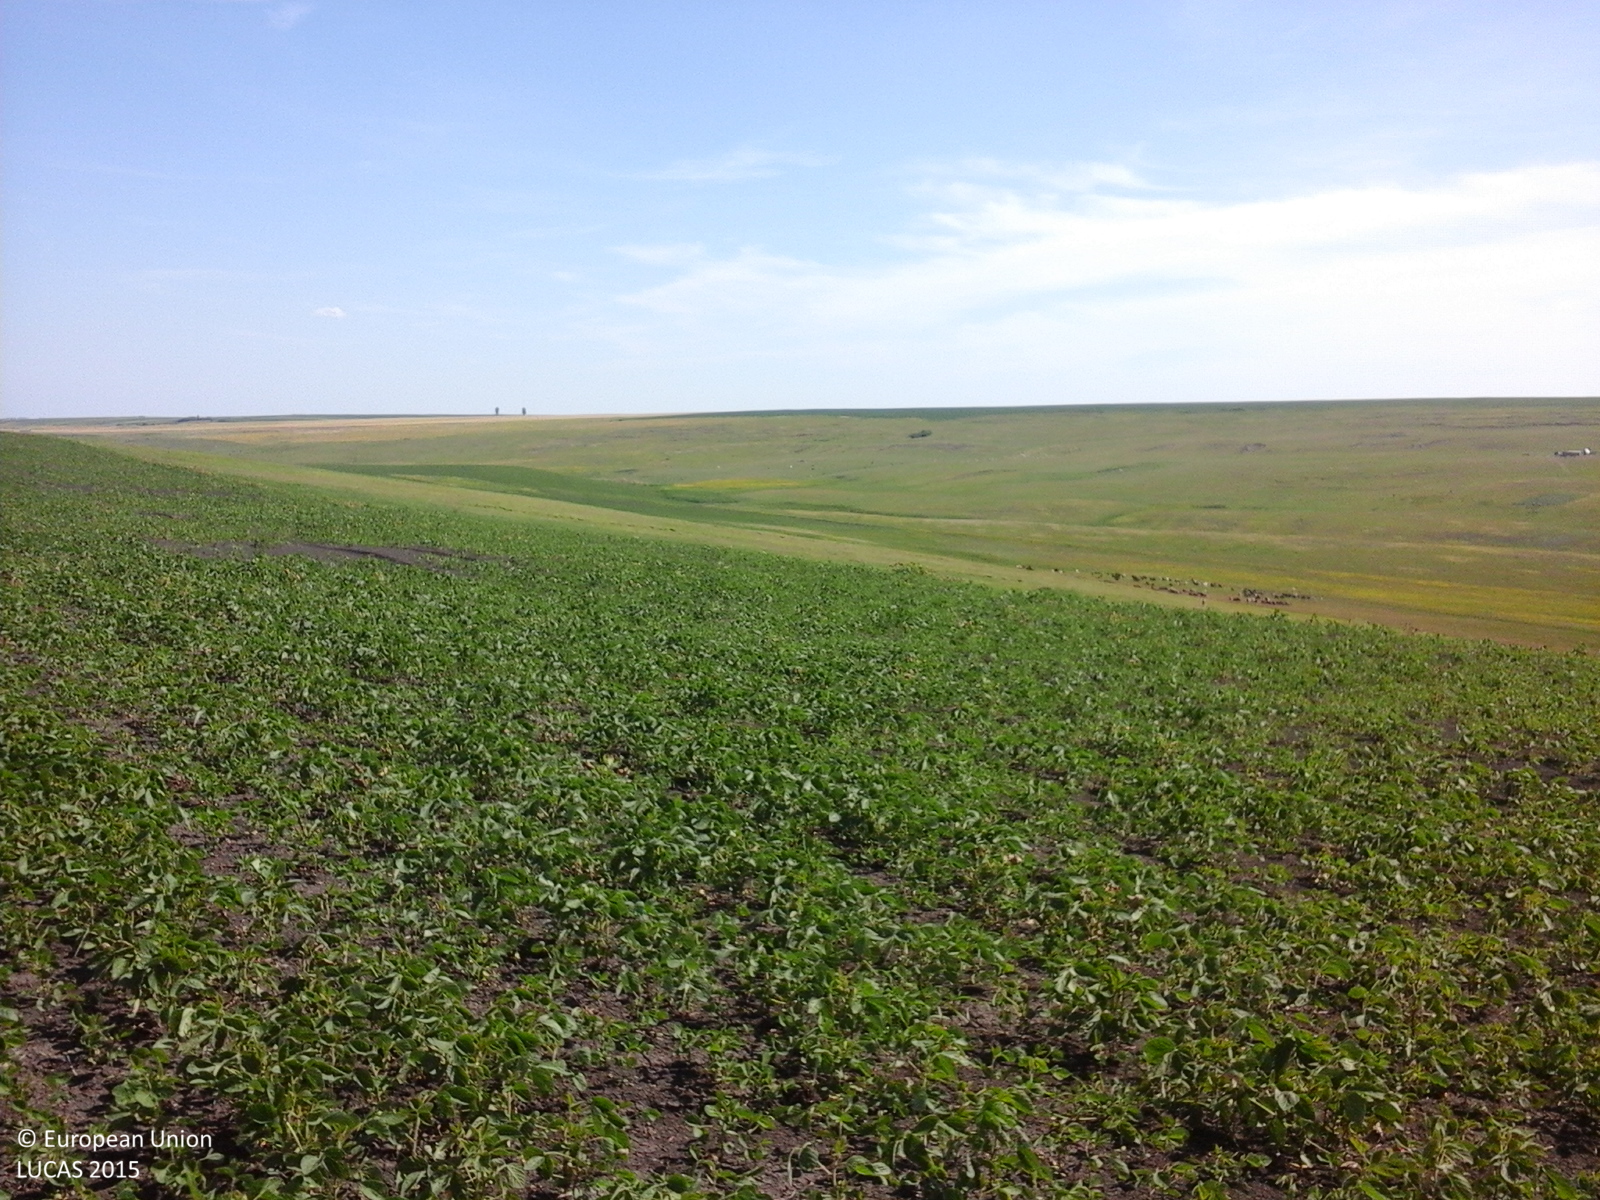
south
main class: Cropland
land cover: Soya
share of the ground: > 75 %
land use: Agriculture (excluding fallow land and kitchen gardens)
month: June
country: RO
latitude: 48.2162
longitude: 26.7489
